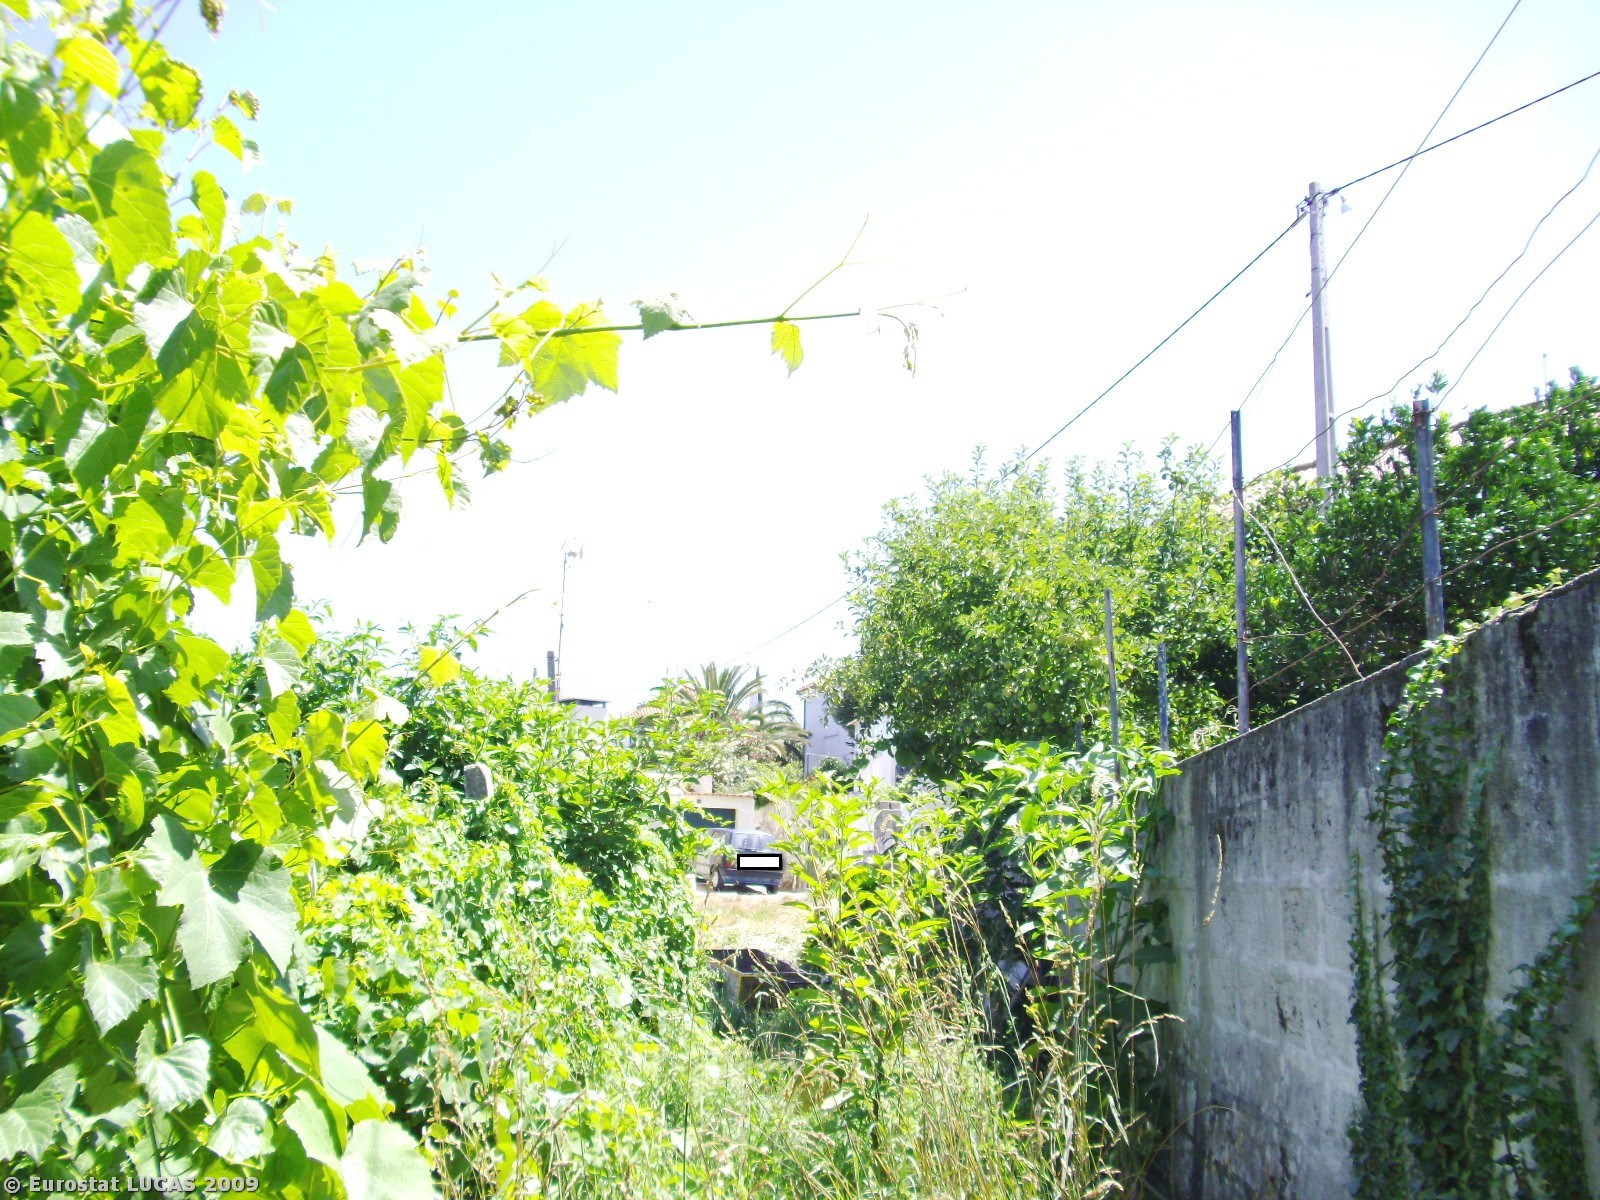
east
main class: Shrubland
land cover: Shrubland with sparse tree cover
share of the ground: > 75 %
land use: Unused
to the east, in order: Shrubland with sparse tree cover; Artificial constructions in urban areas; Permanent crops (only in case pi); Vineyards; Spontaneously vegetated surfaces; Artificial constructions in urban areas; Fences; Electric lines; Tracks; Fences; Artificial constructions in urban areas; Other fresh vegetables; Arable land (only in case pi); Tracks; Electric lines; Dry stone walls; Spontaneously vegetated surfaces; Artificial constructions in urban areas
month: July
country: PT
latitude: 41.7100
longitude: -8.7838
